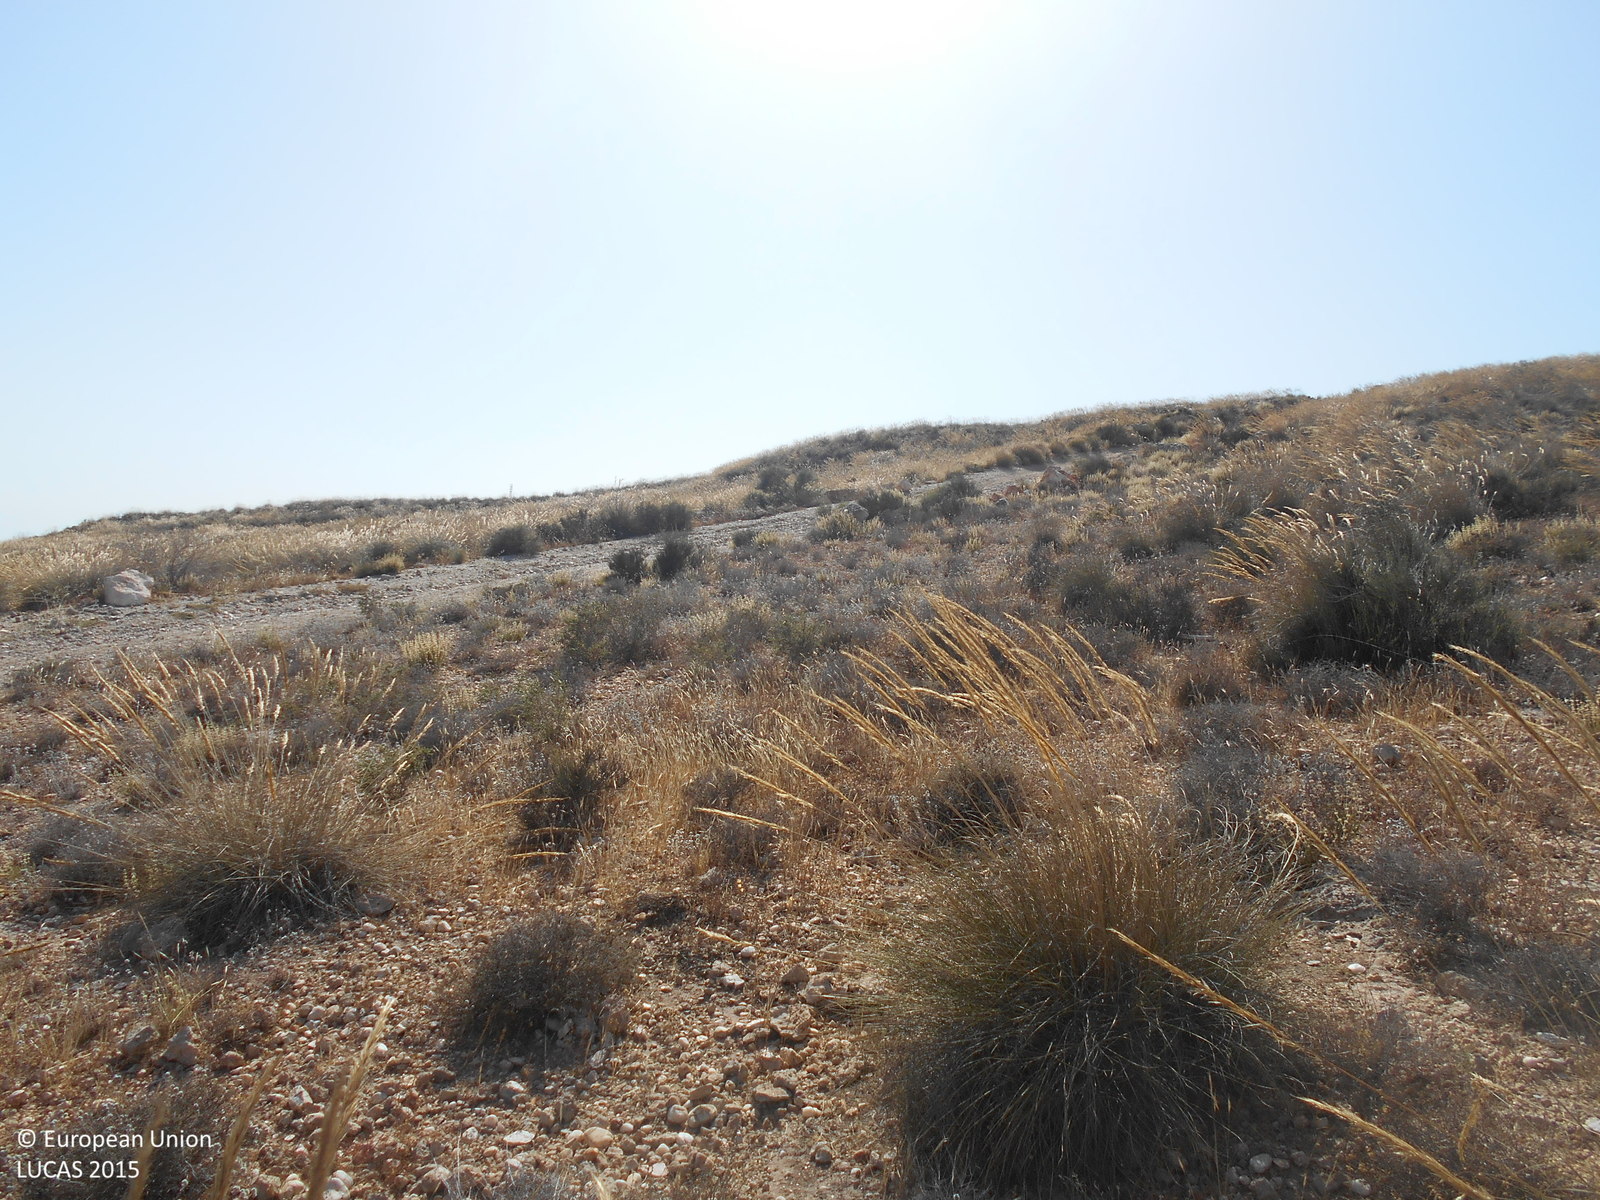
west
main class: Shrubland
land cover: Shrubland without tree cover
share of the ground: 25 - 50 %
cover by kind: shrubs 40 %, unconsolidated bare surface 30 %, consolidated bare surface 20 %, herbaceous plants 10 %
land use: Semi-natural and natural areas not in use
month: May
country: ES
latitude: 36.8269
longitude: -2.2279
